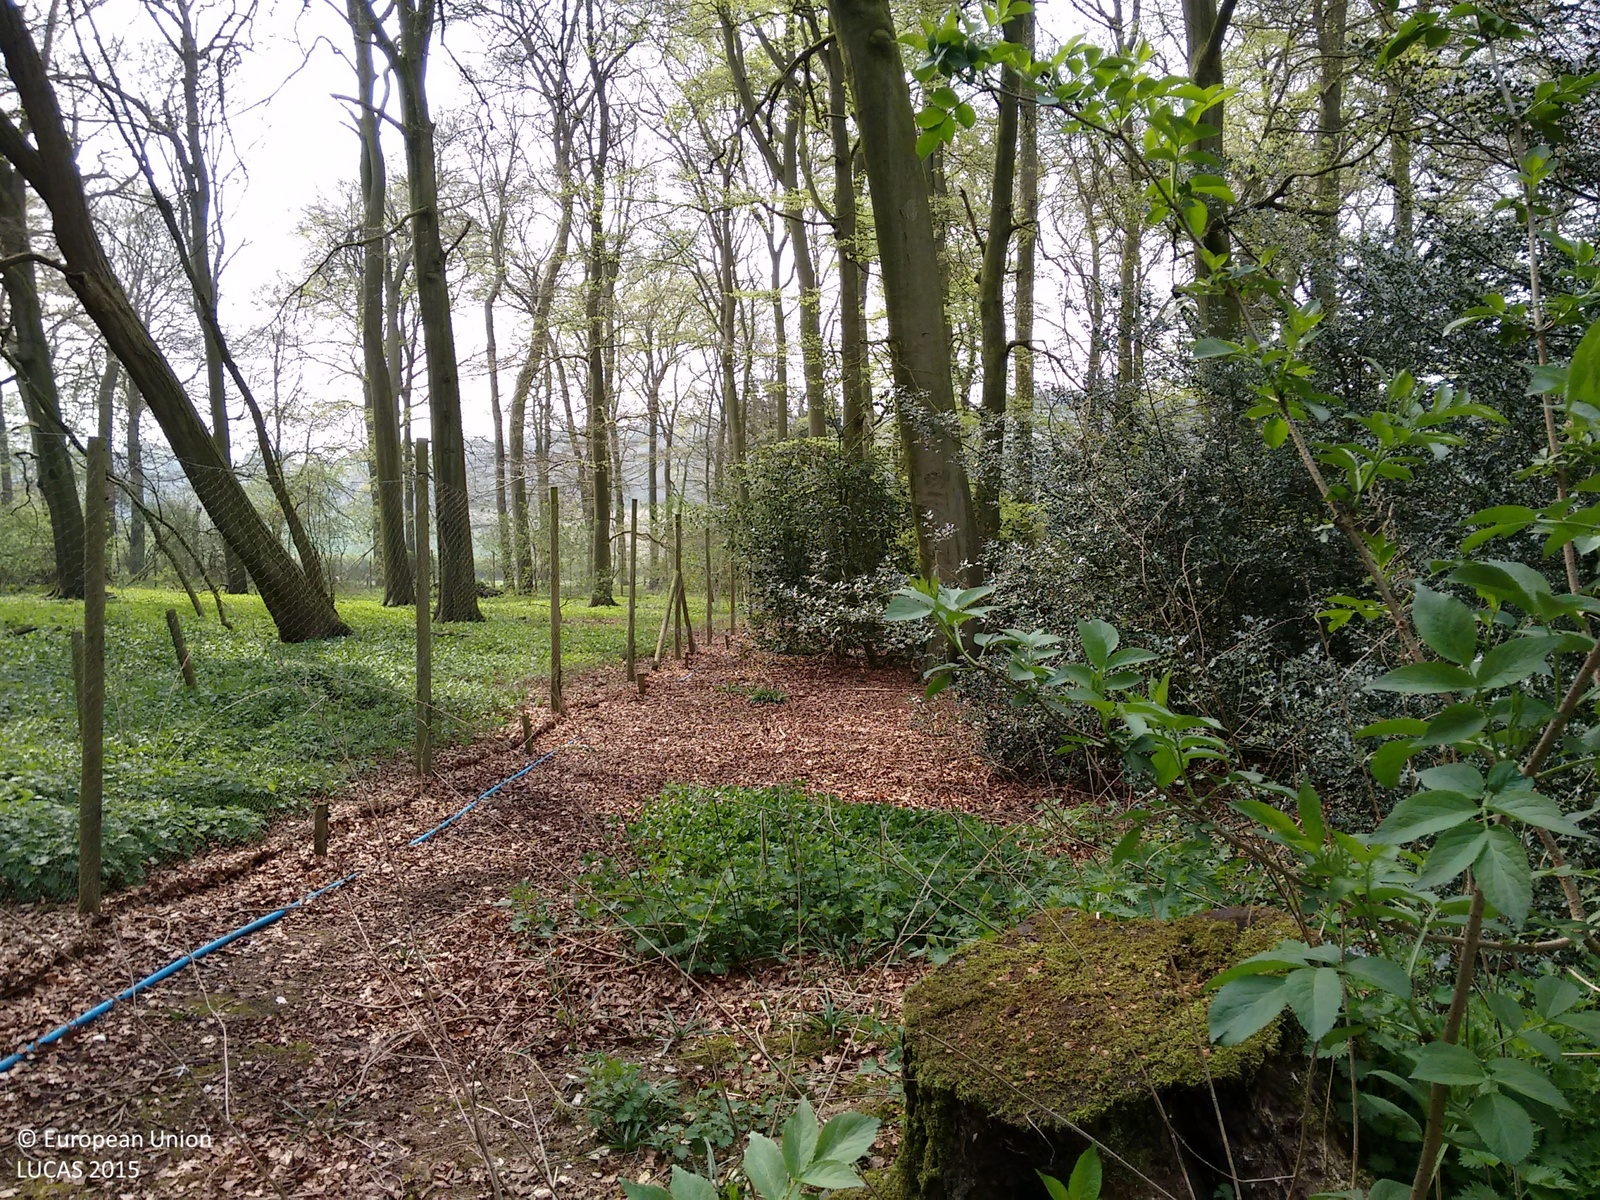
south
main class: Woodland
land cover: Broadleaved woodland
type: mesophytic deciduous forest
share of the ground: > 75 %
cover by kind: broadleaved forest trees 100 %
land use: Forestry
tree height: > 5 m
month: April
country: GB
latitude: 51.7228
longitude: -0.7686
